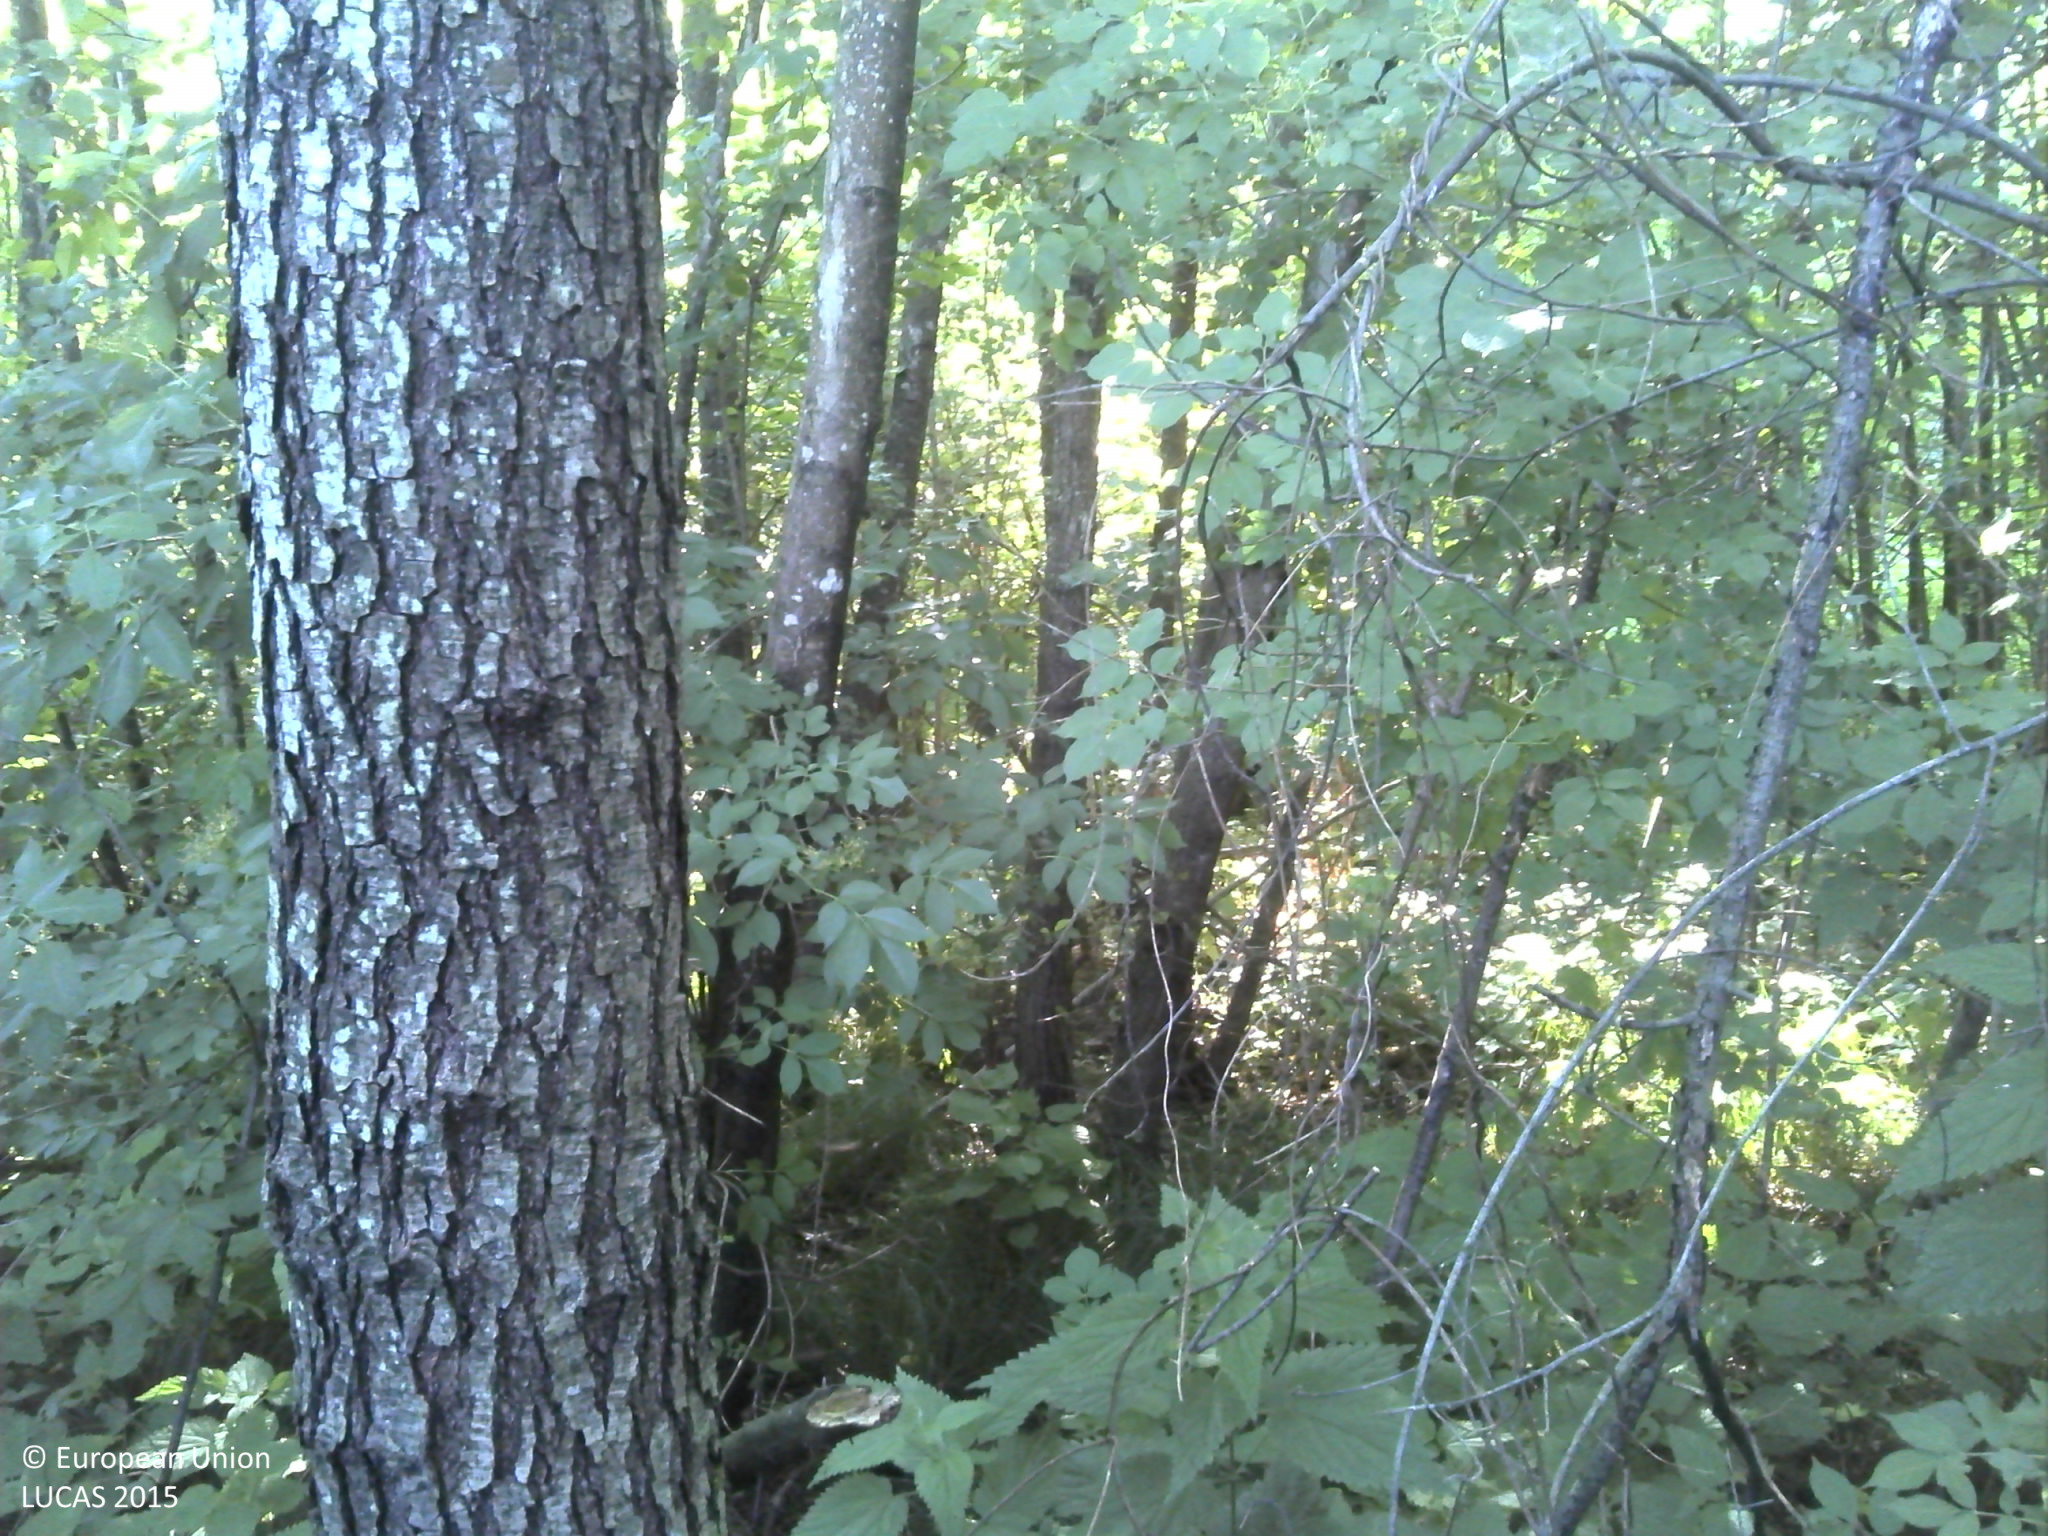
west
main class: Woodland
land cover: Broadleaved woodland
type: beech forest
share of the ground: > 75 %
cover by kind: broadleaved forest trees 80 %, lichens and mosses 20 %
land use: Forestry
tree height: > 5 m
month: June
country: HR
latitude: 45.4967
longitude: 17.1536
